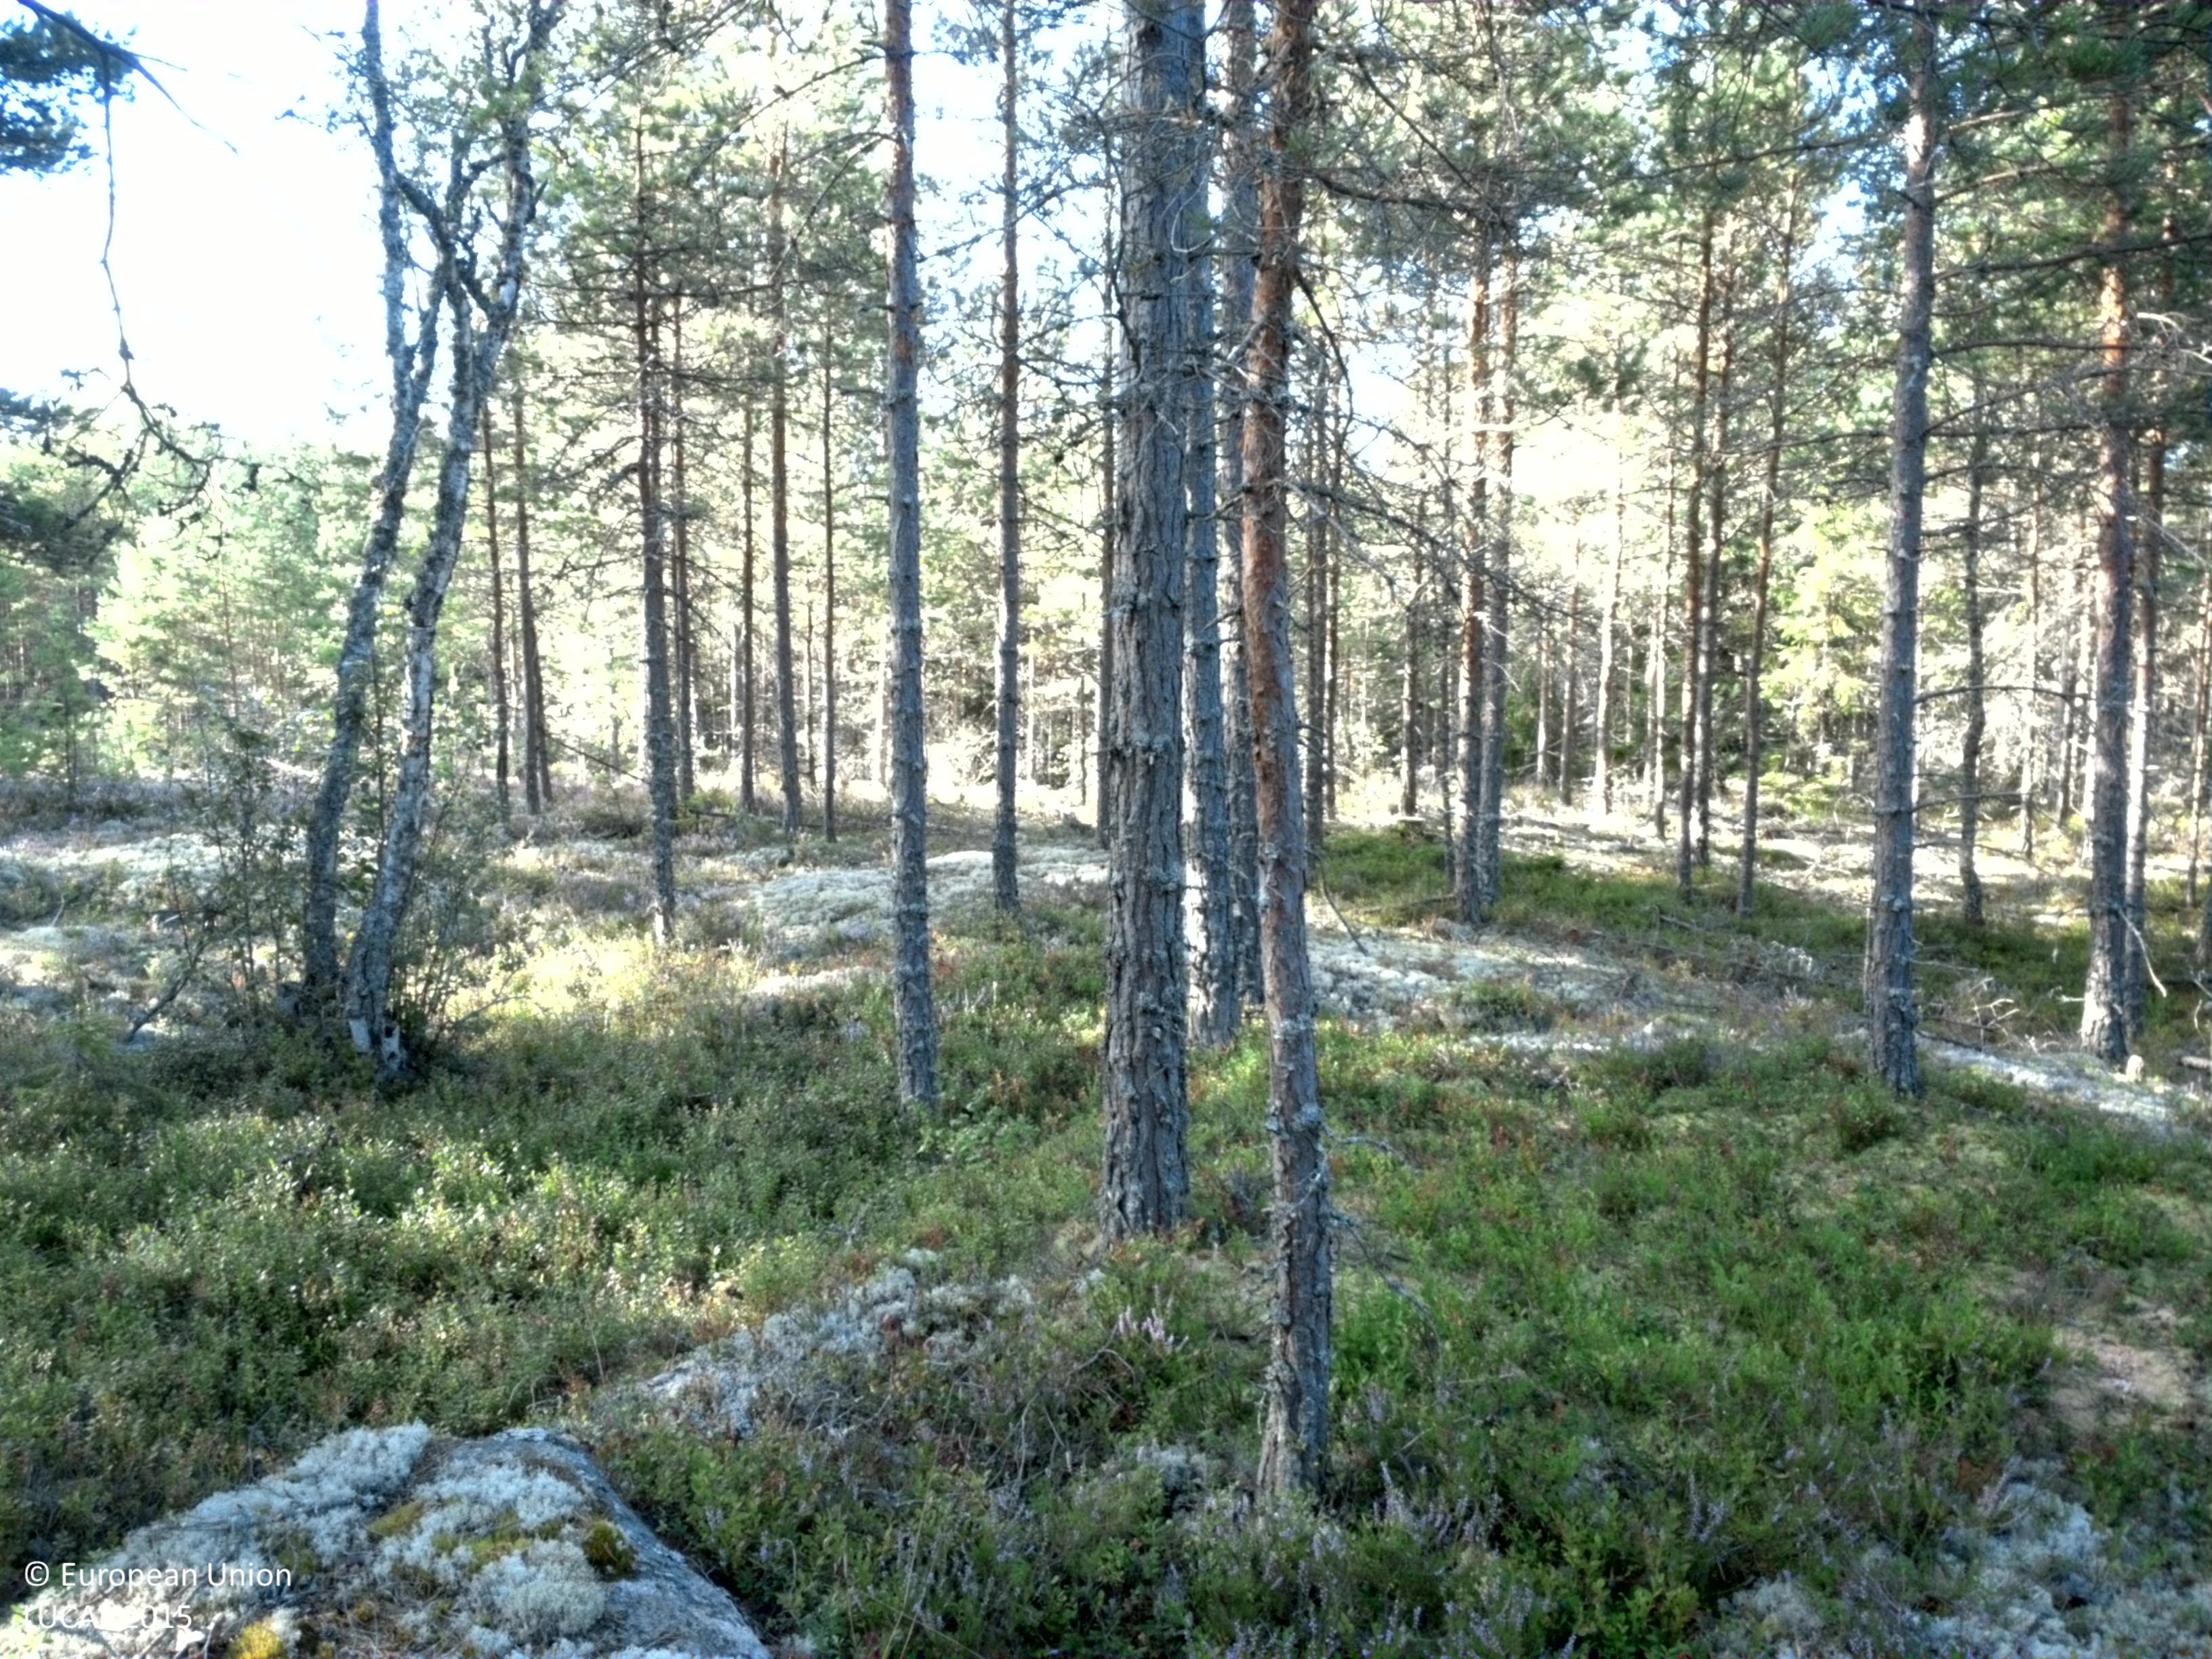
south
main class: Woodland
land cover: Pine dominated coniferous woodland
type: boreal forest
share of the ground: 25 - 50 %
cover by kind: coniferous forest trees 40 %, lichens and mosses 35 %, shrubs 25 %
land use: Forestry
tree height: > 5 m
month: August
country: SE
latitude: 59.8921
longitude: 17.1234
